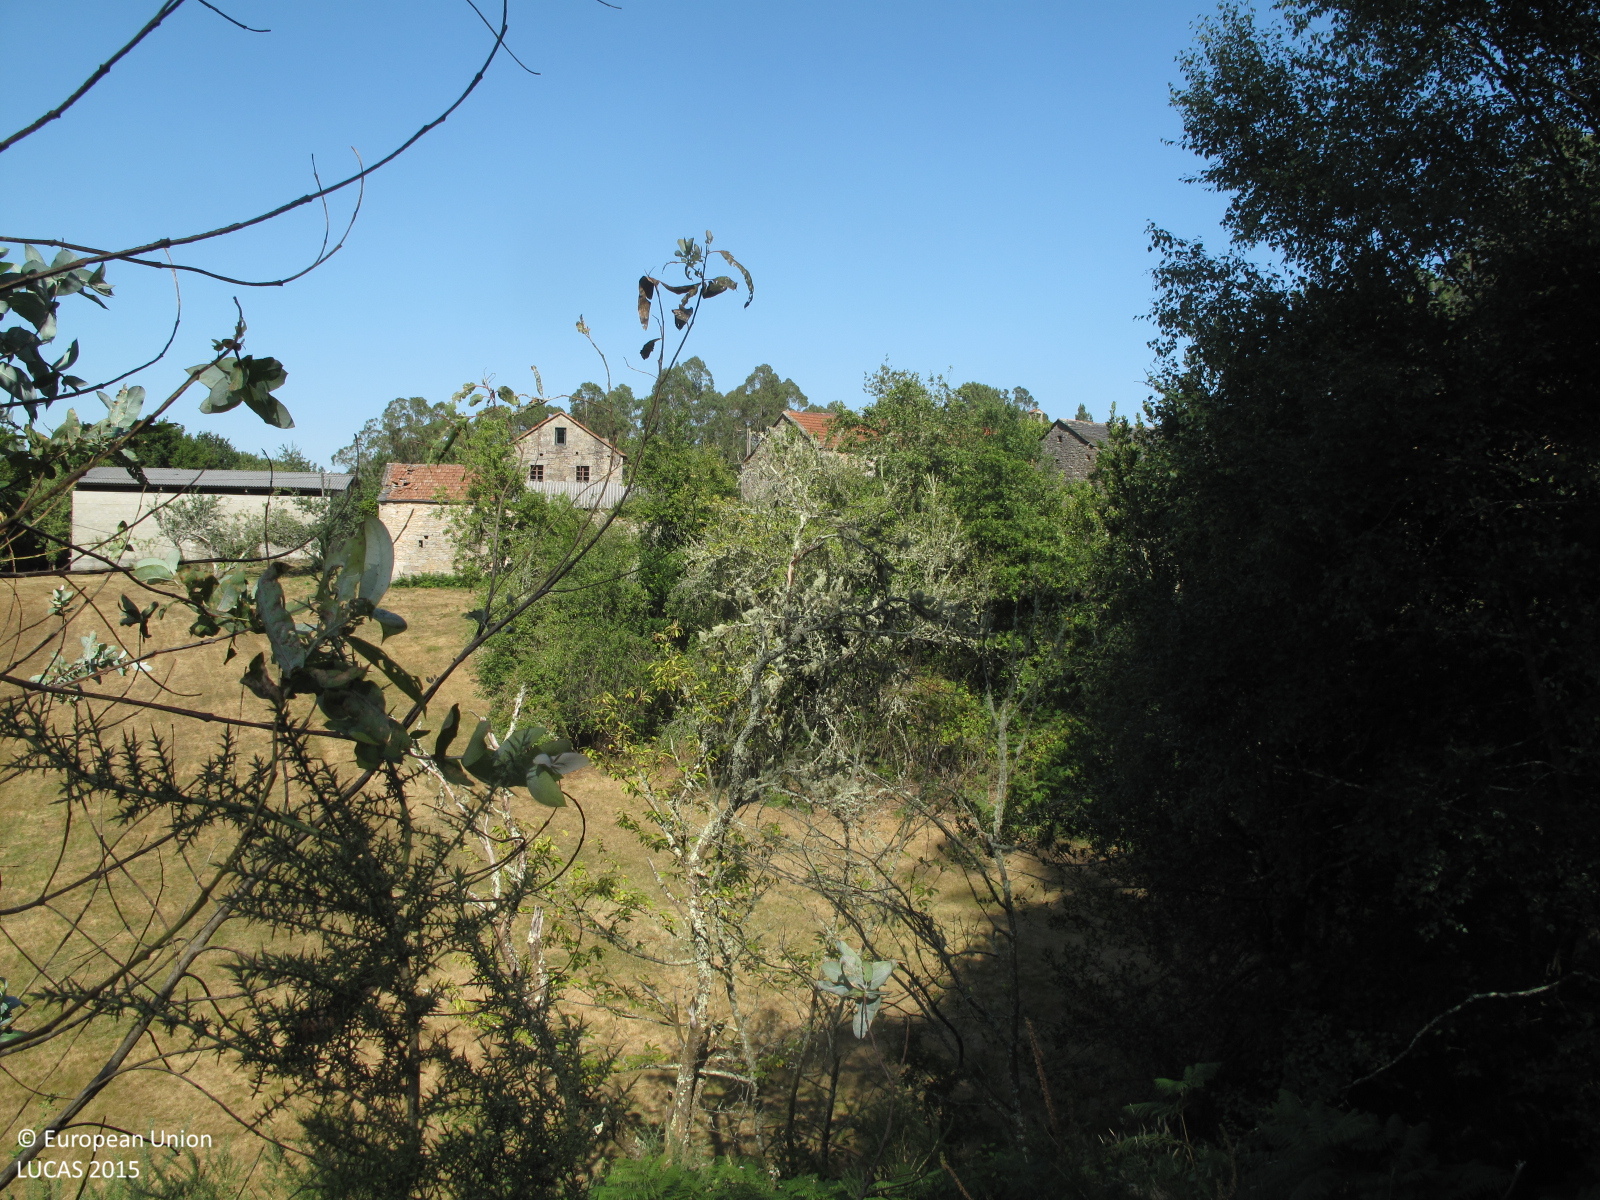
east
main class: Grassland
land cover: Grassland with sparse tree/shrub cover
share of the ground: 50 - 75 %
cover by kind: herbaceous plants 70 %, unconsolidated bare surface 20 %, broadleaved forest trees 5 %, shrubs 5 %
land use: Forestry
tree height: < 5 m
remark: Clear cut
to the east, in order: Grassland with sparse tree/shrub cover; Grassland without tree/shrub cover; Shrubland with sparse tree cover; Broadleaved woodland; Artificial constructions in urban areas; Grassland with sparse tree/shrub cover; Paved roads, cycling and walking lanes; Grassland with sparse tree/shrub cover; Grassland without tree/shrub cover; Other fresh vegetables; Grassland without tree/shrub cover; Other mixed woodland
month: July
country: ES
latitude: 43.3518
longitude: -8.0974
